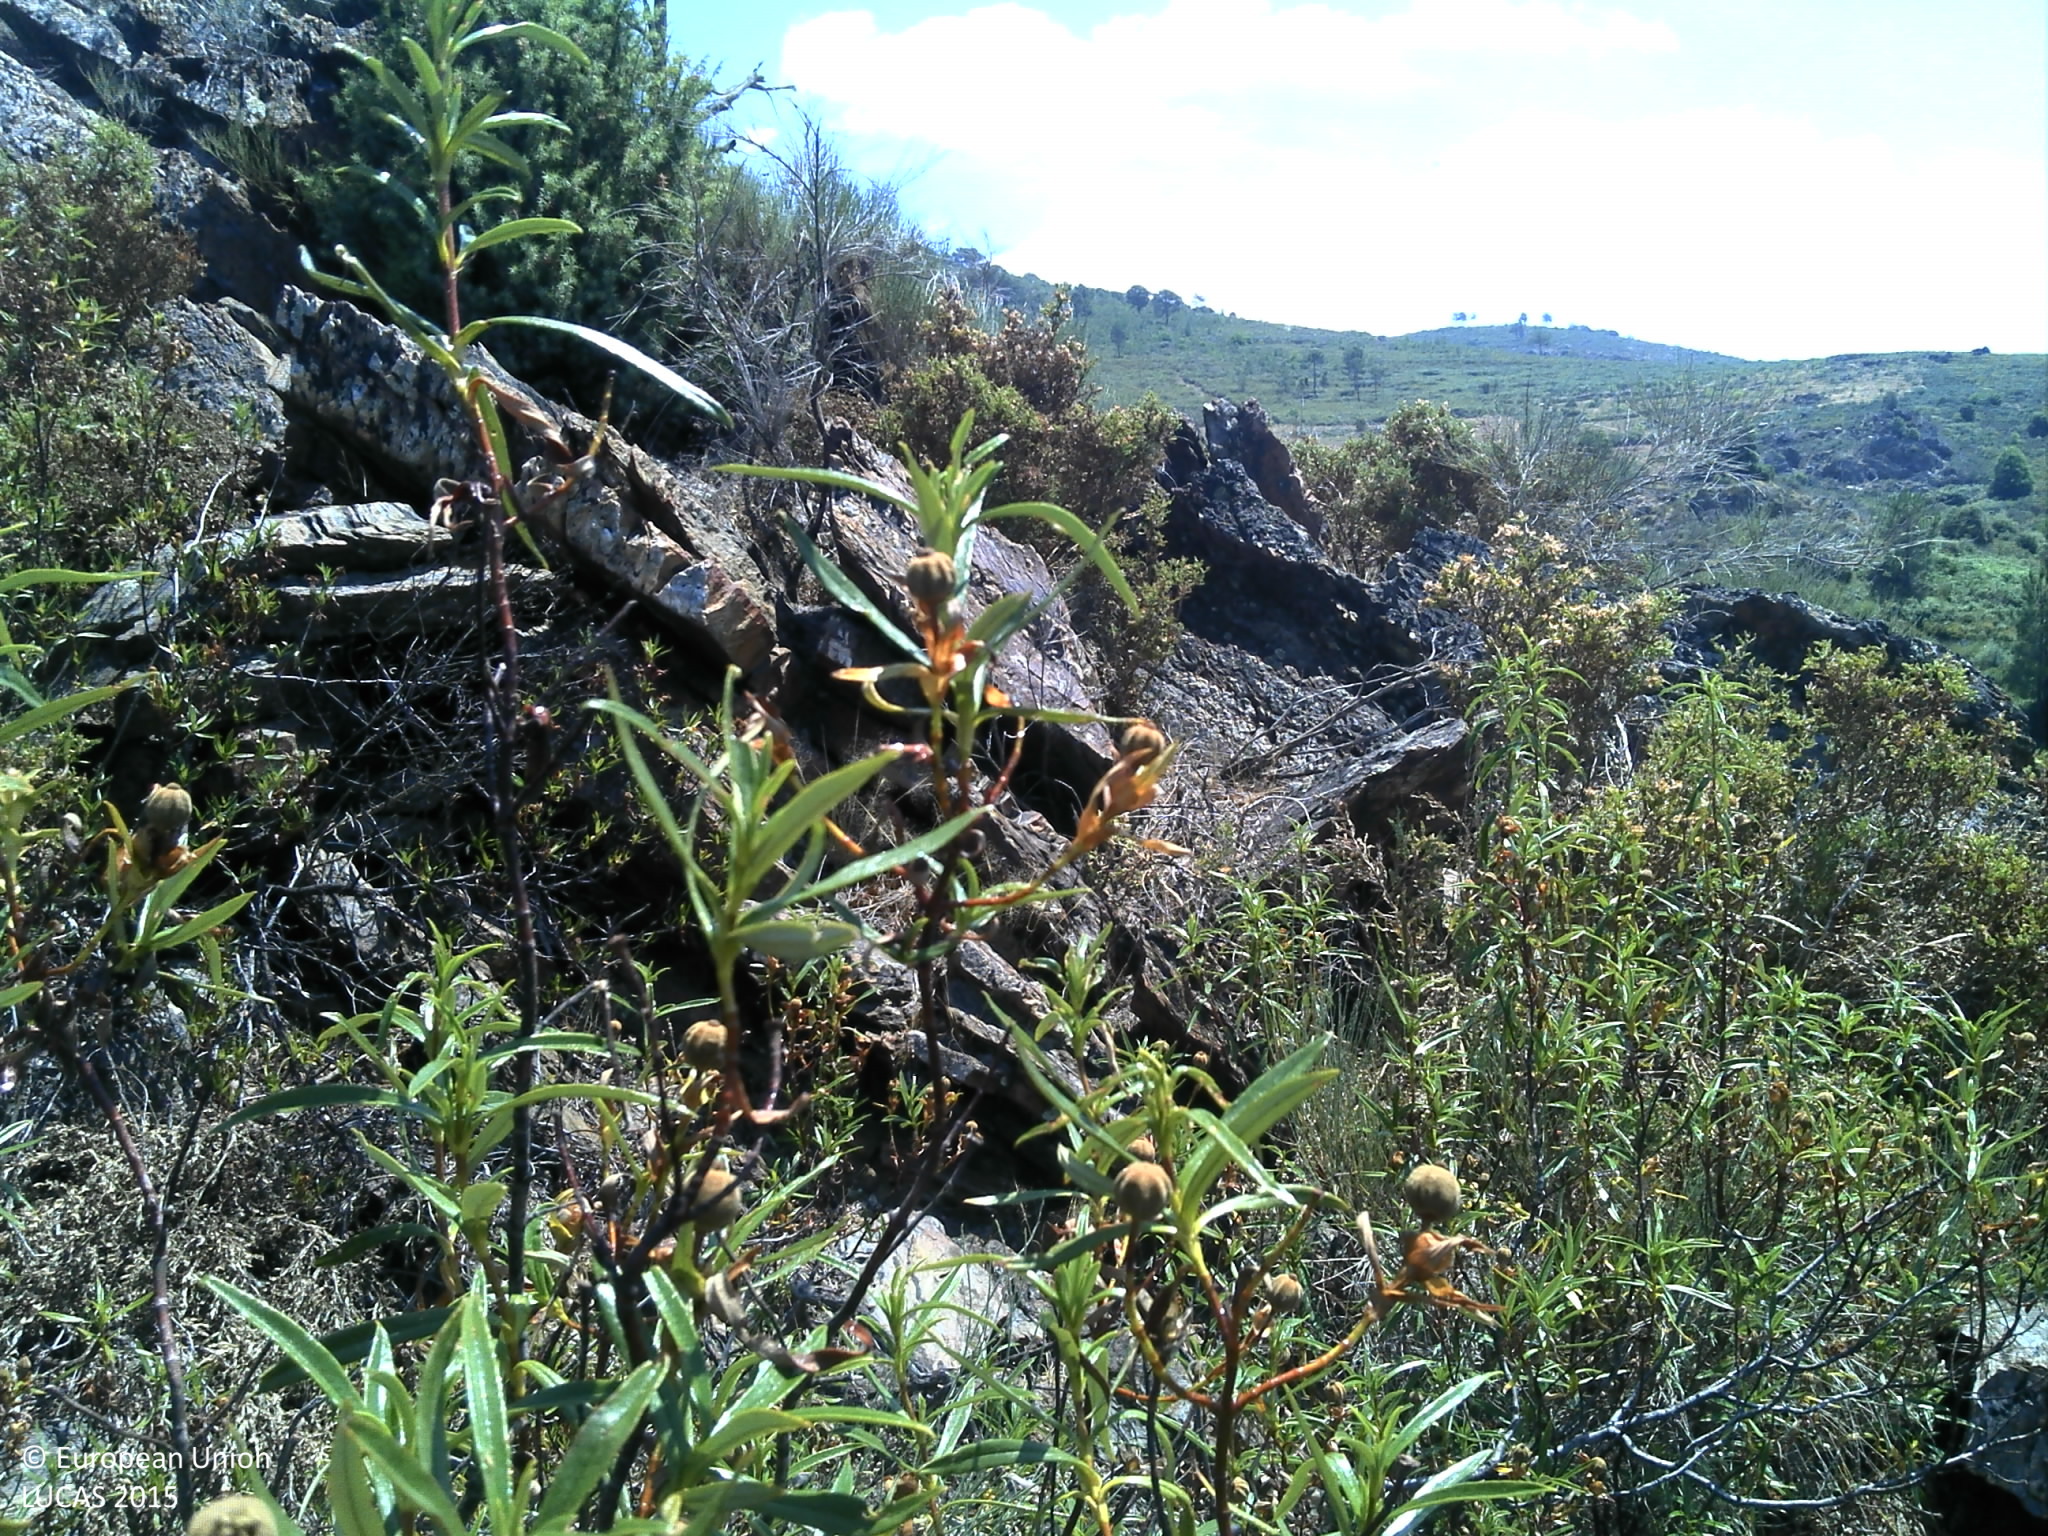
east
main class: Shrubland
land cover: Shrubland without tree cover
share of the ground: > 75 %
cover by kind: shrubs 90 %, consolidated bare surface 5 %, unconsolidated bare surface 5 %
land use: Semi-natural and natural areas not in use
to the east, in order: Shrubland without tree cover; Rock outcrops; Shrubland without tree cover; Shrubland with sparse tree cover; Rock outcrops; Shrubland without tree cover; Pine dominated coniferous woodland; Shrubland with sparse tree cover; Nuts trees; Tracks; Shruby margins; Inland fresh running water; Shrubland without tree cover; Olive groves
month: June
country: PT
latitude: 41.1558
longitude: -7.0682
